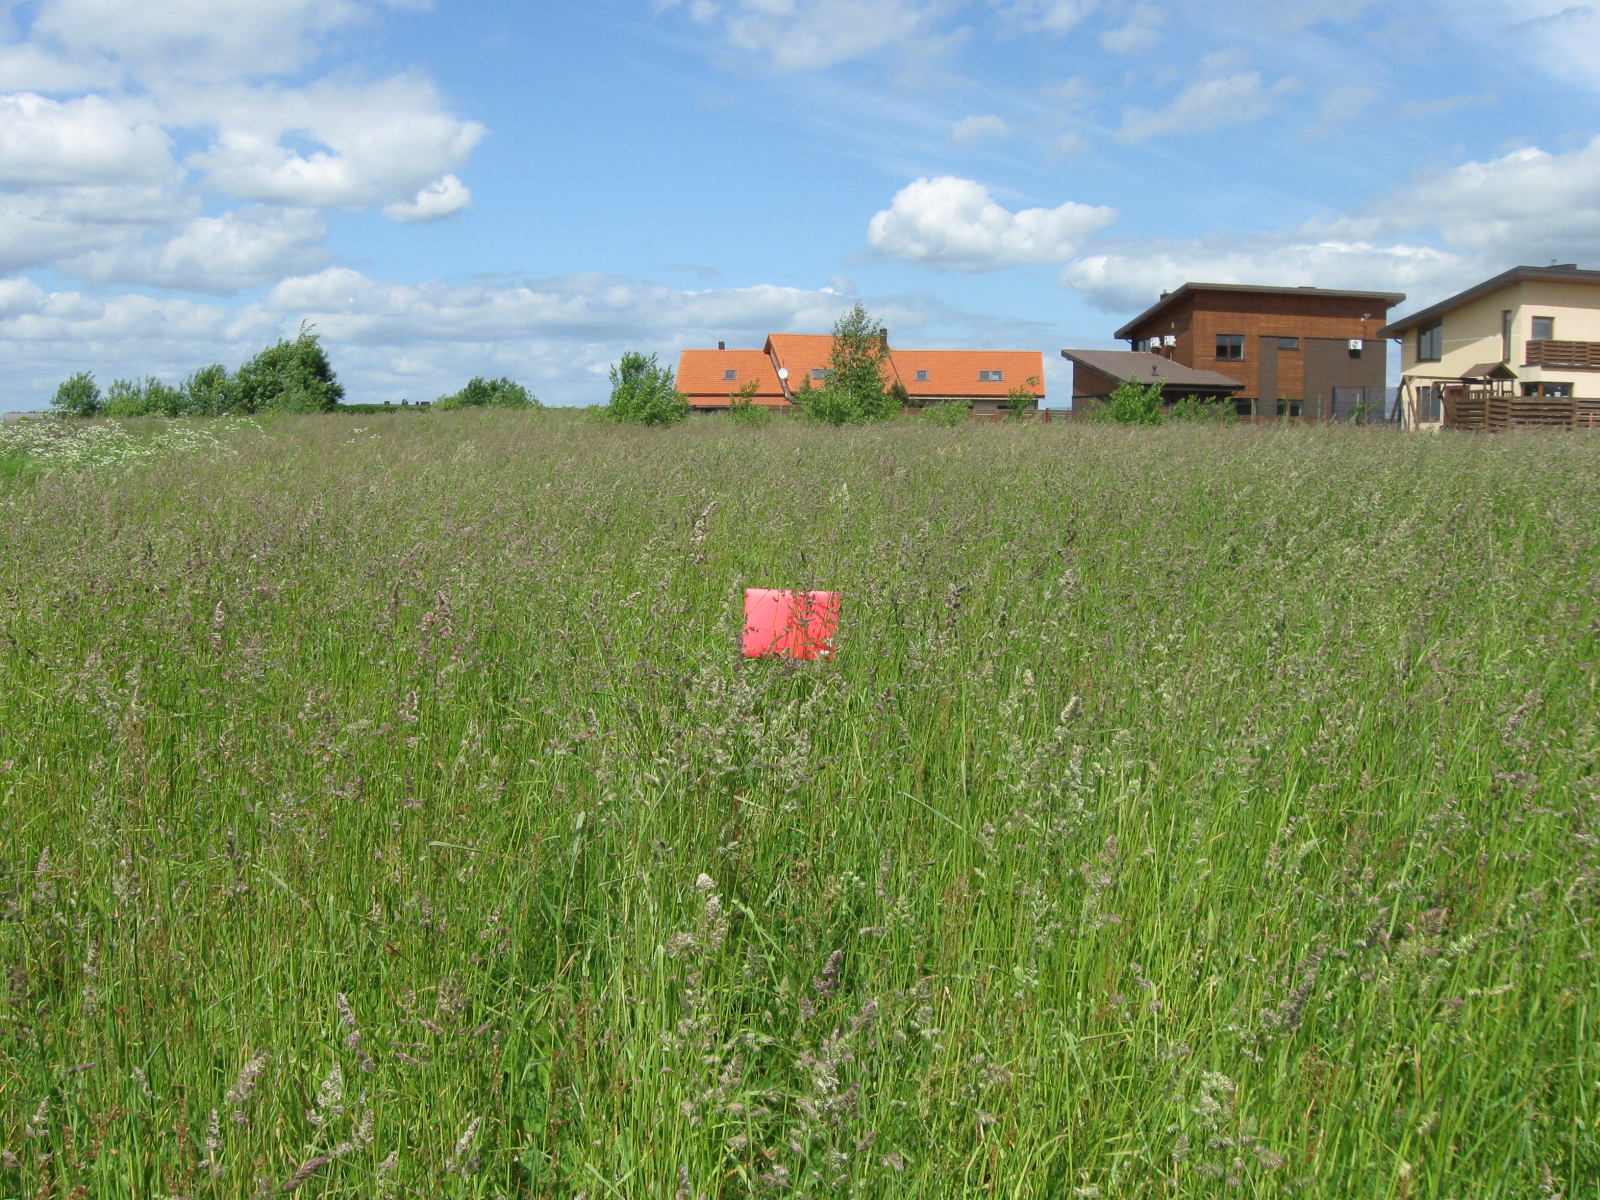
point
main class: Grassland
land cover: Grassland without tree/shrub cover
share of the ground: > 75 %
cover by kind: herbaceous plants 100 %
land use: Agriculture (excluding fallow land and kitchen gardens)
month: June
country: LT
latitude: 54.9606
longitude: 23.8150
